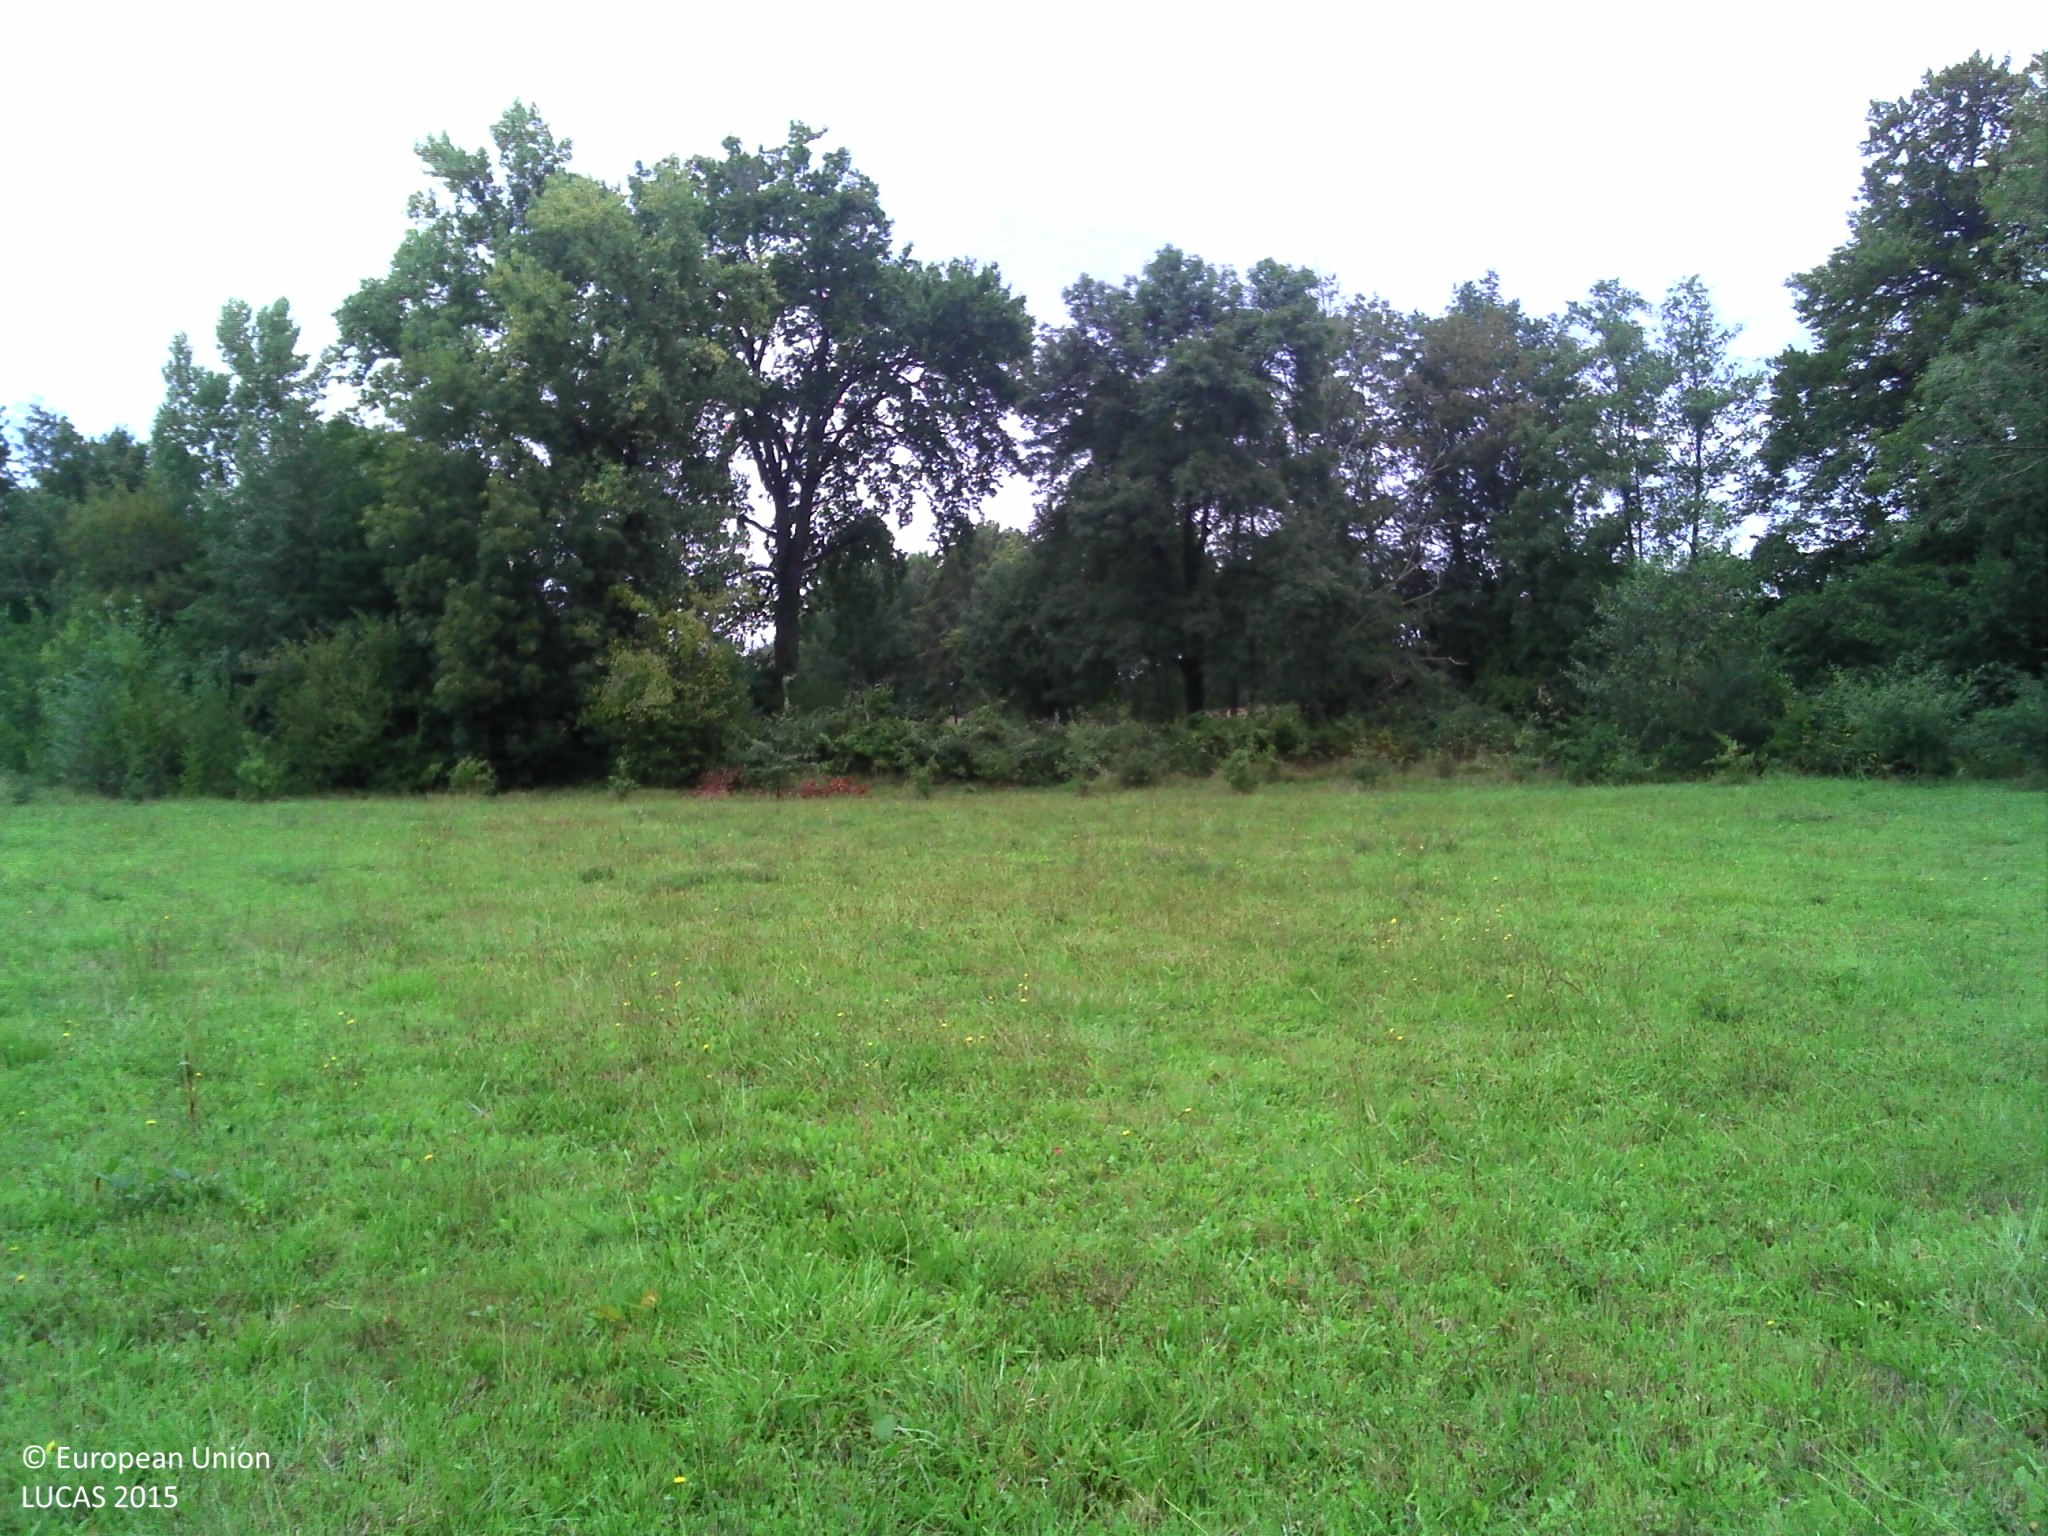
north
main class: Grassland
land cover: Grassland without tree/shrub cover
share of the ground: > 75 %
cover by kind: herbaceous plants 100 %
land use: Agriculture (excluding fallow land and kitchen gardens)
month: September
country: FR
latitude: 43.3100
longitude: -0.4749
